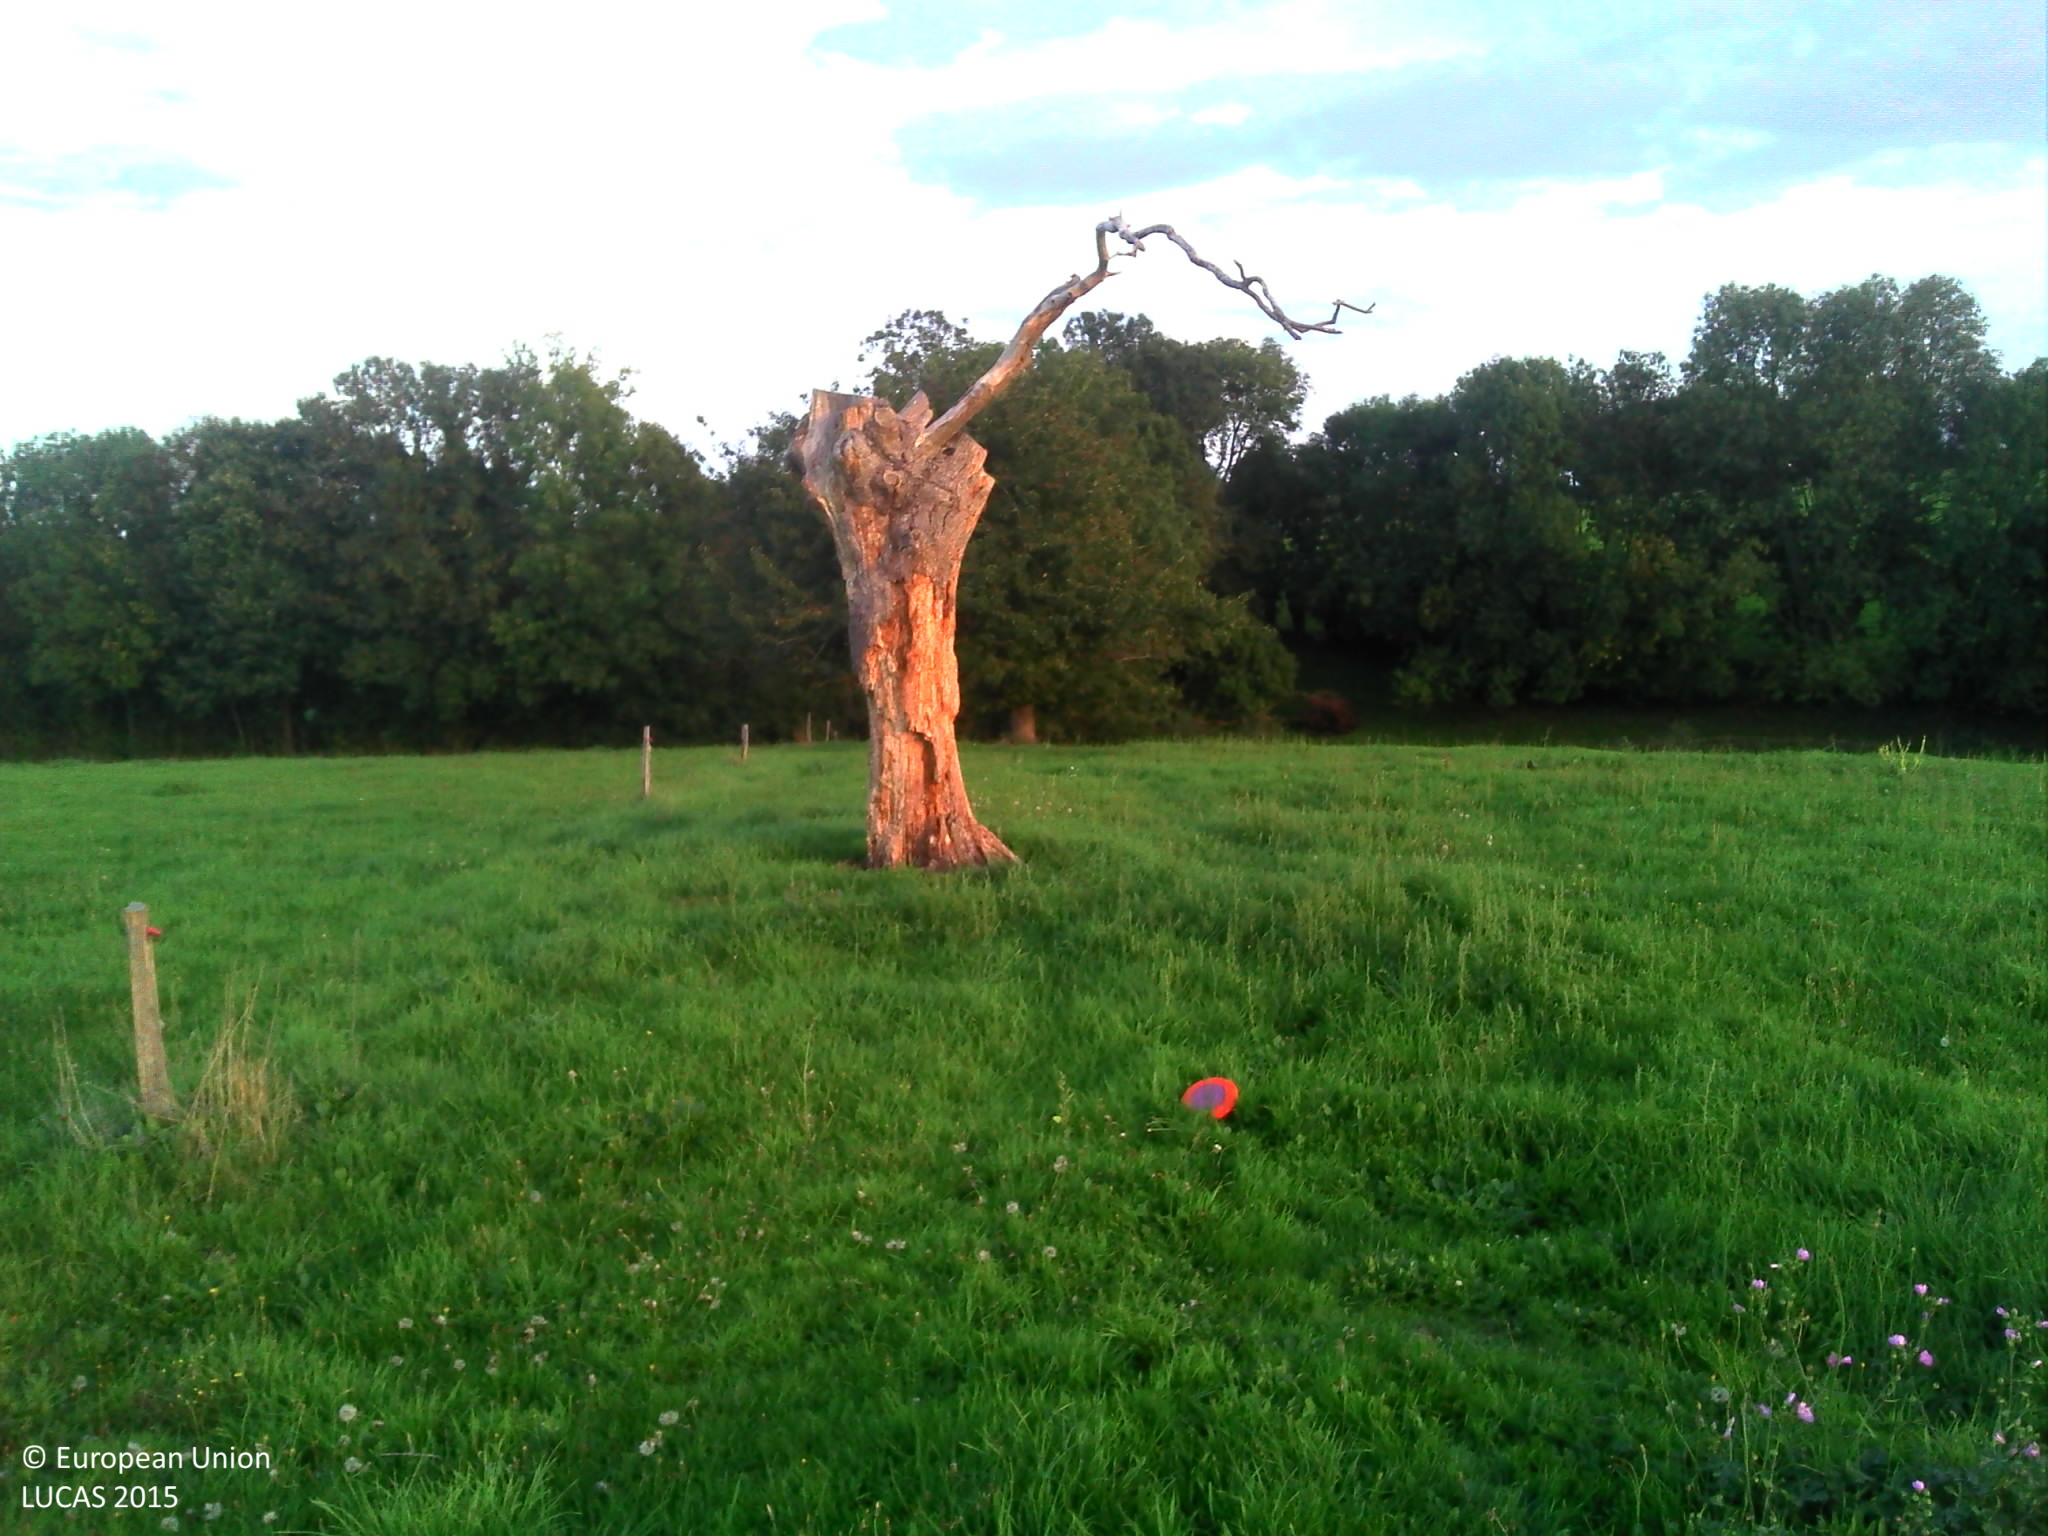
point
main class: Grassland
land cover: Grassland without tree/shrub cover
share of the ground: > 75 %
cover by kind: herbaceous plants 100 %
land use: Agriculture (excluding fallow land and kitchen gardens)
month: September
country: FR
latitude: 46.7923
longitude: -0.8925
